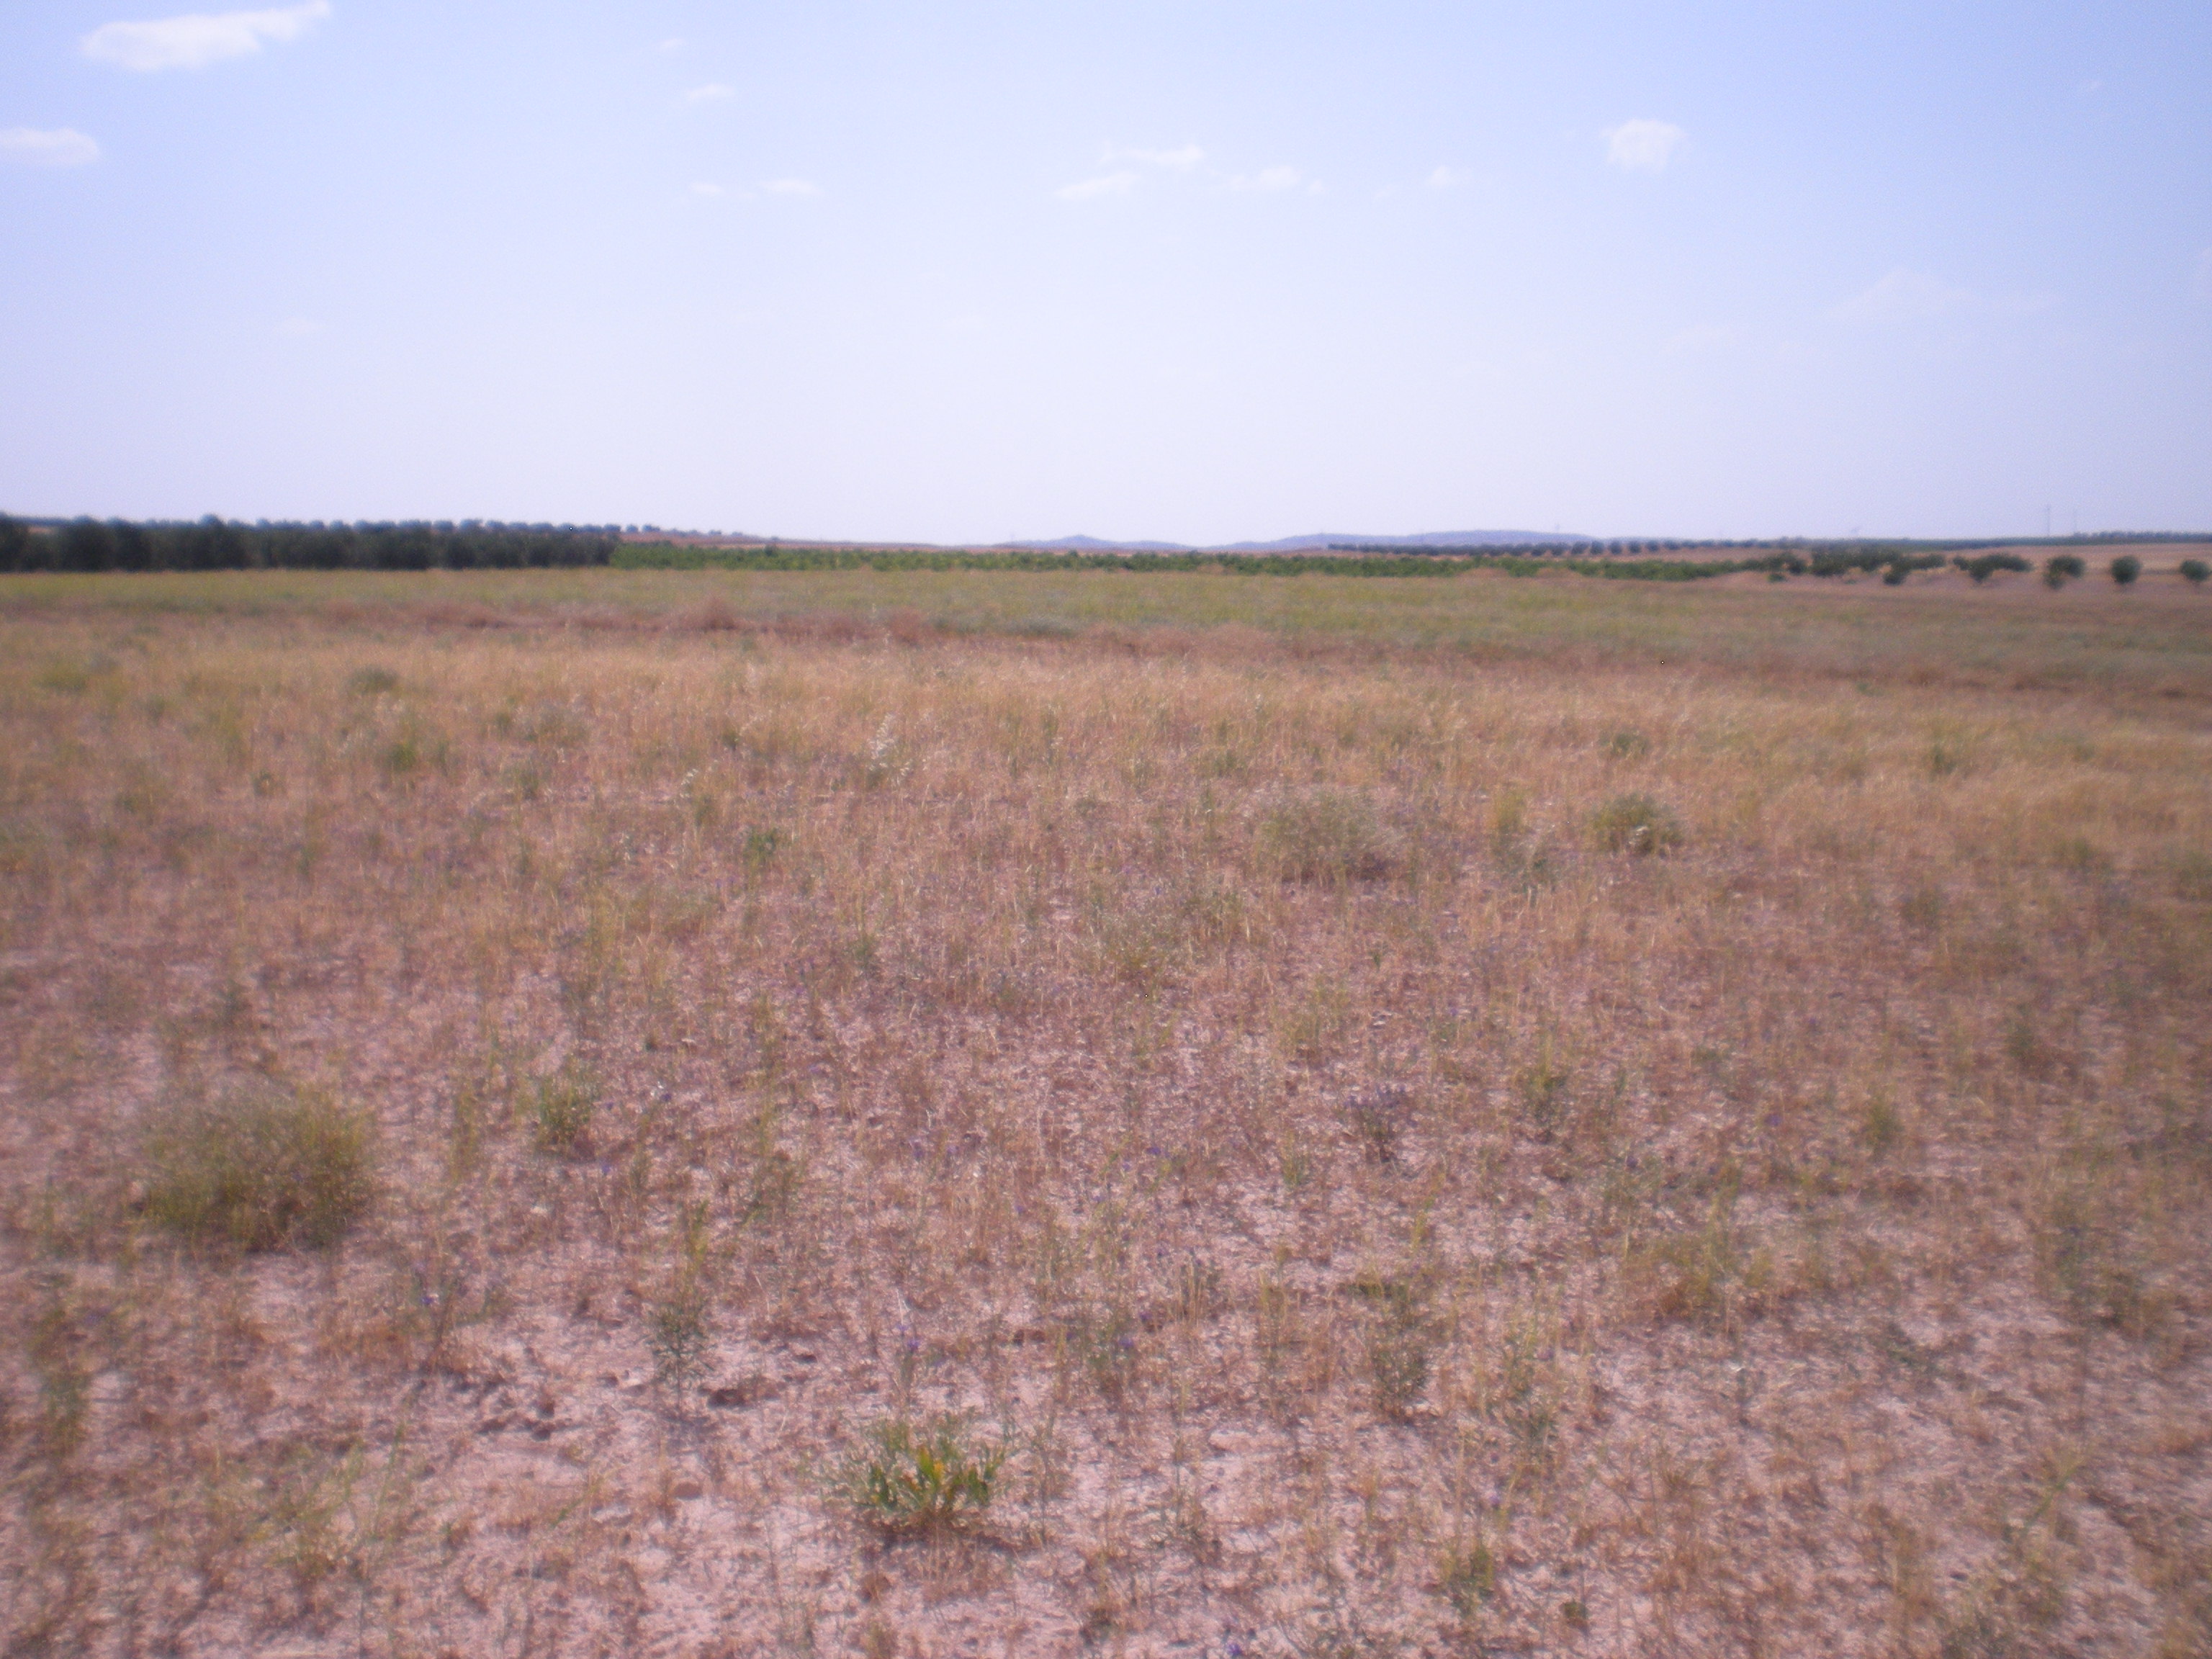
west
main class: Cropland
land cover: Barley
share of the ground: < 10 %
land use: Agriculture (excluding fallow land and kitchen gardens)
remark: Harvested field
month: June
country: ES
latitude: 39.5880
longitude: -3.3541
